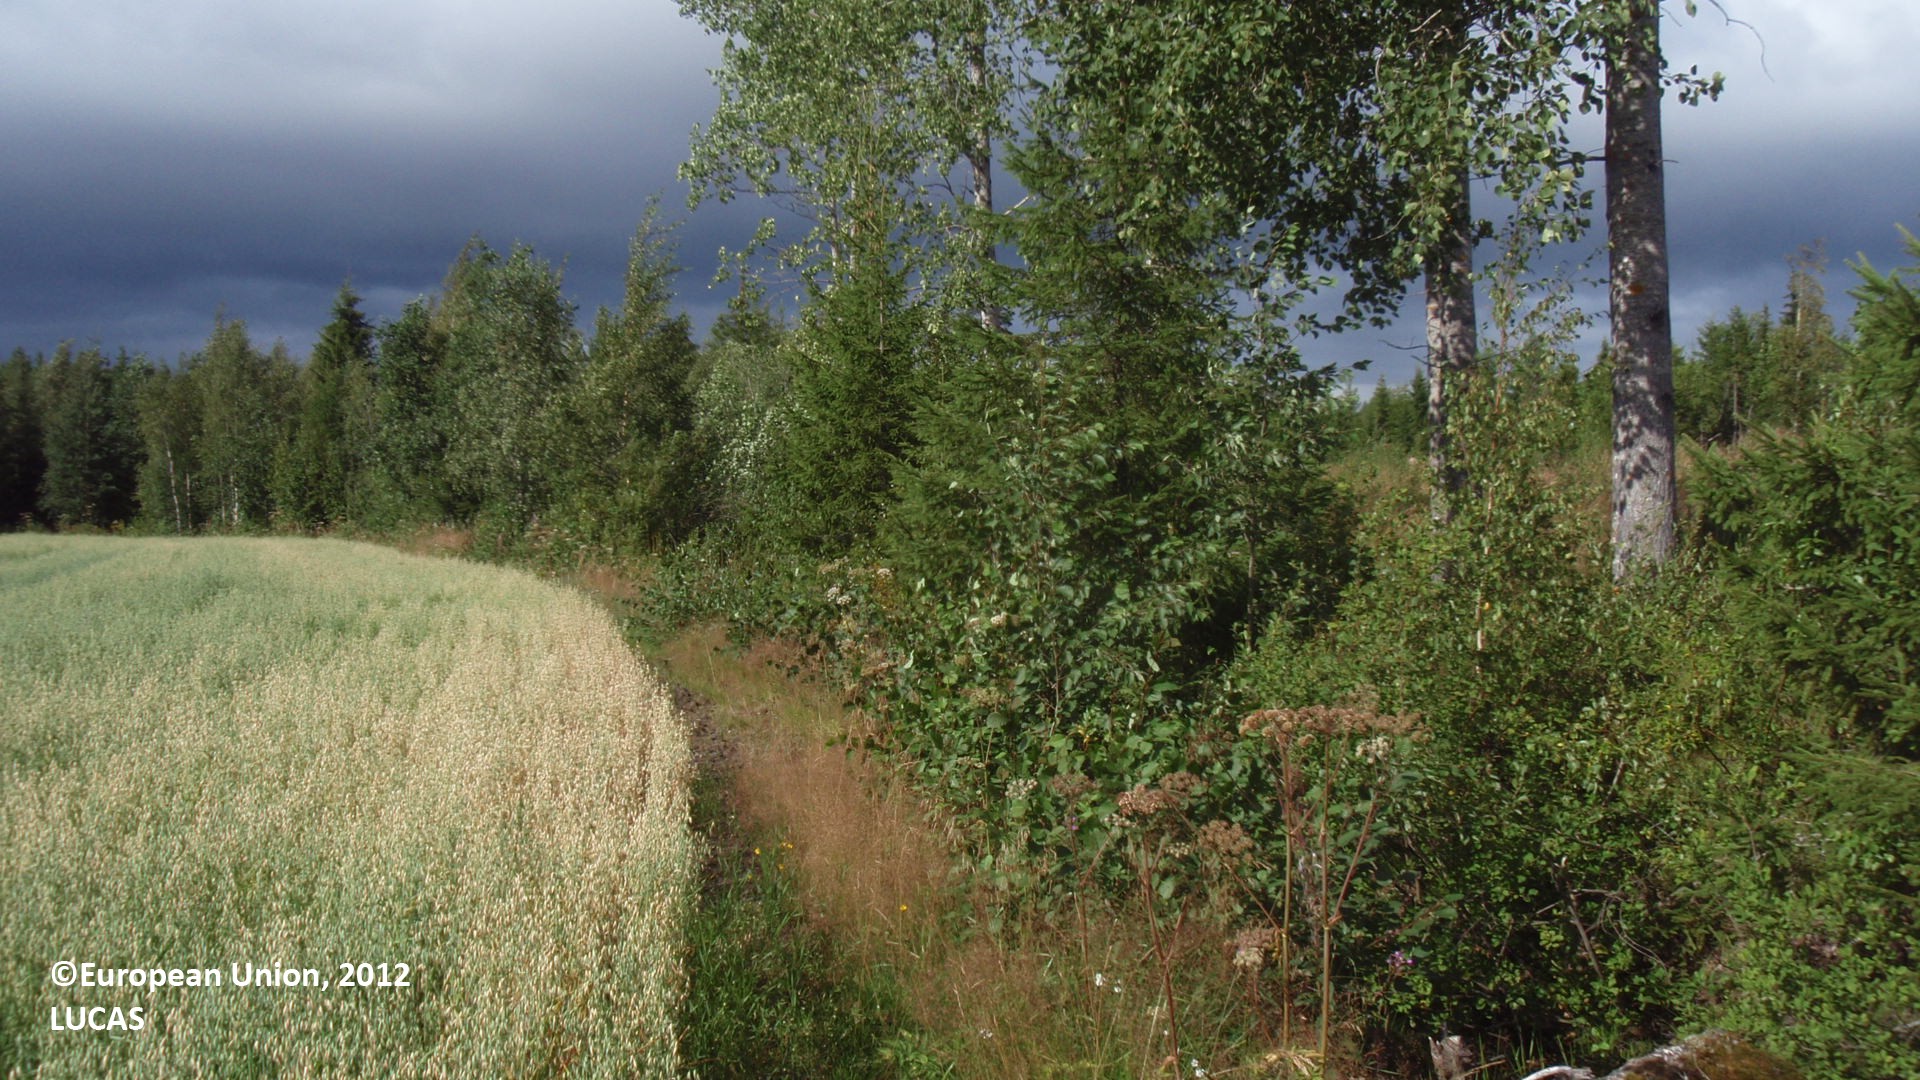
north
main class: Cropland
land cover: Oats
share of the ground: > 75 %
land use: Agriculture (excluding fallow land and kitchen gardens)
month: August
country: FI
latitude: 61.0506
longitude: 27.0775
